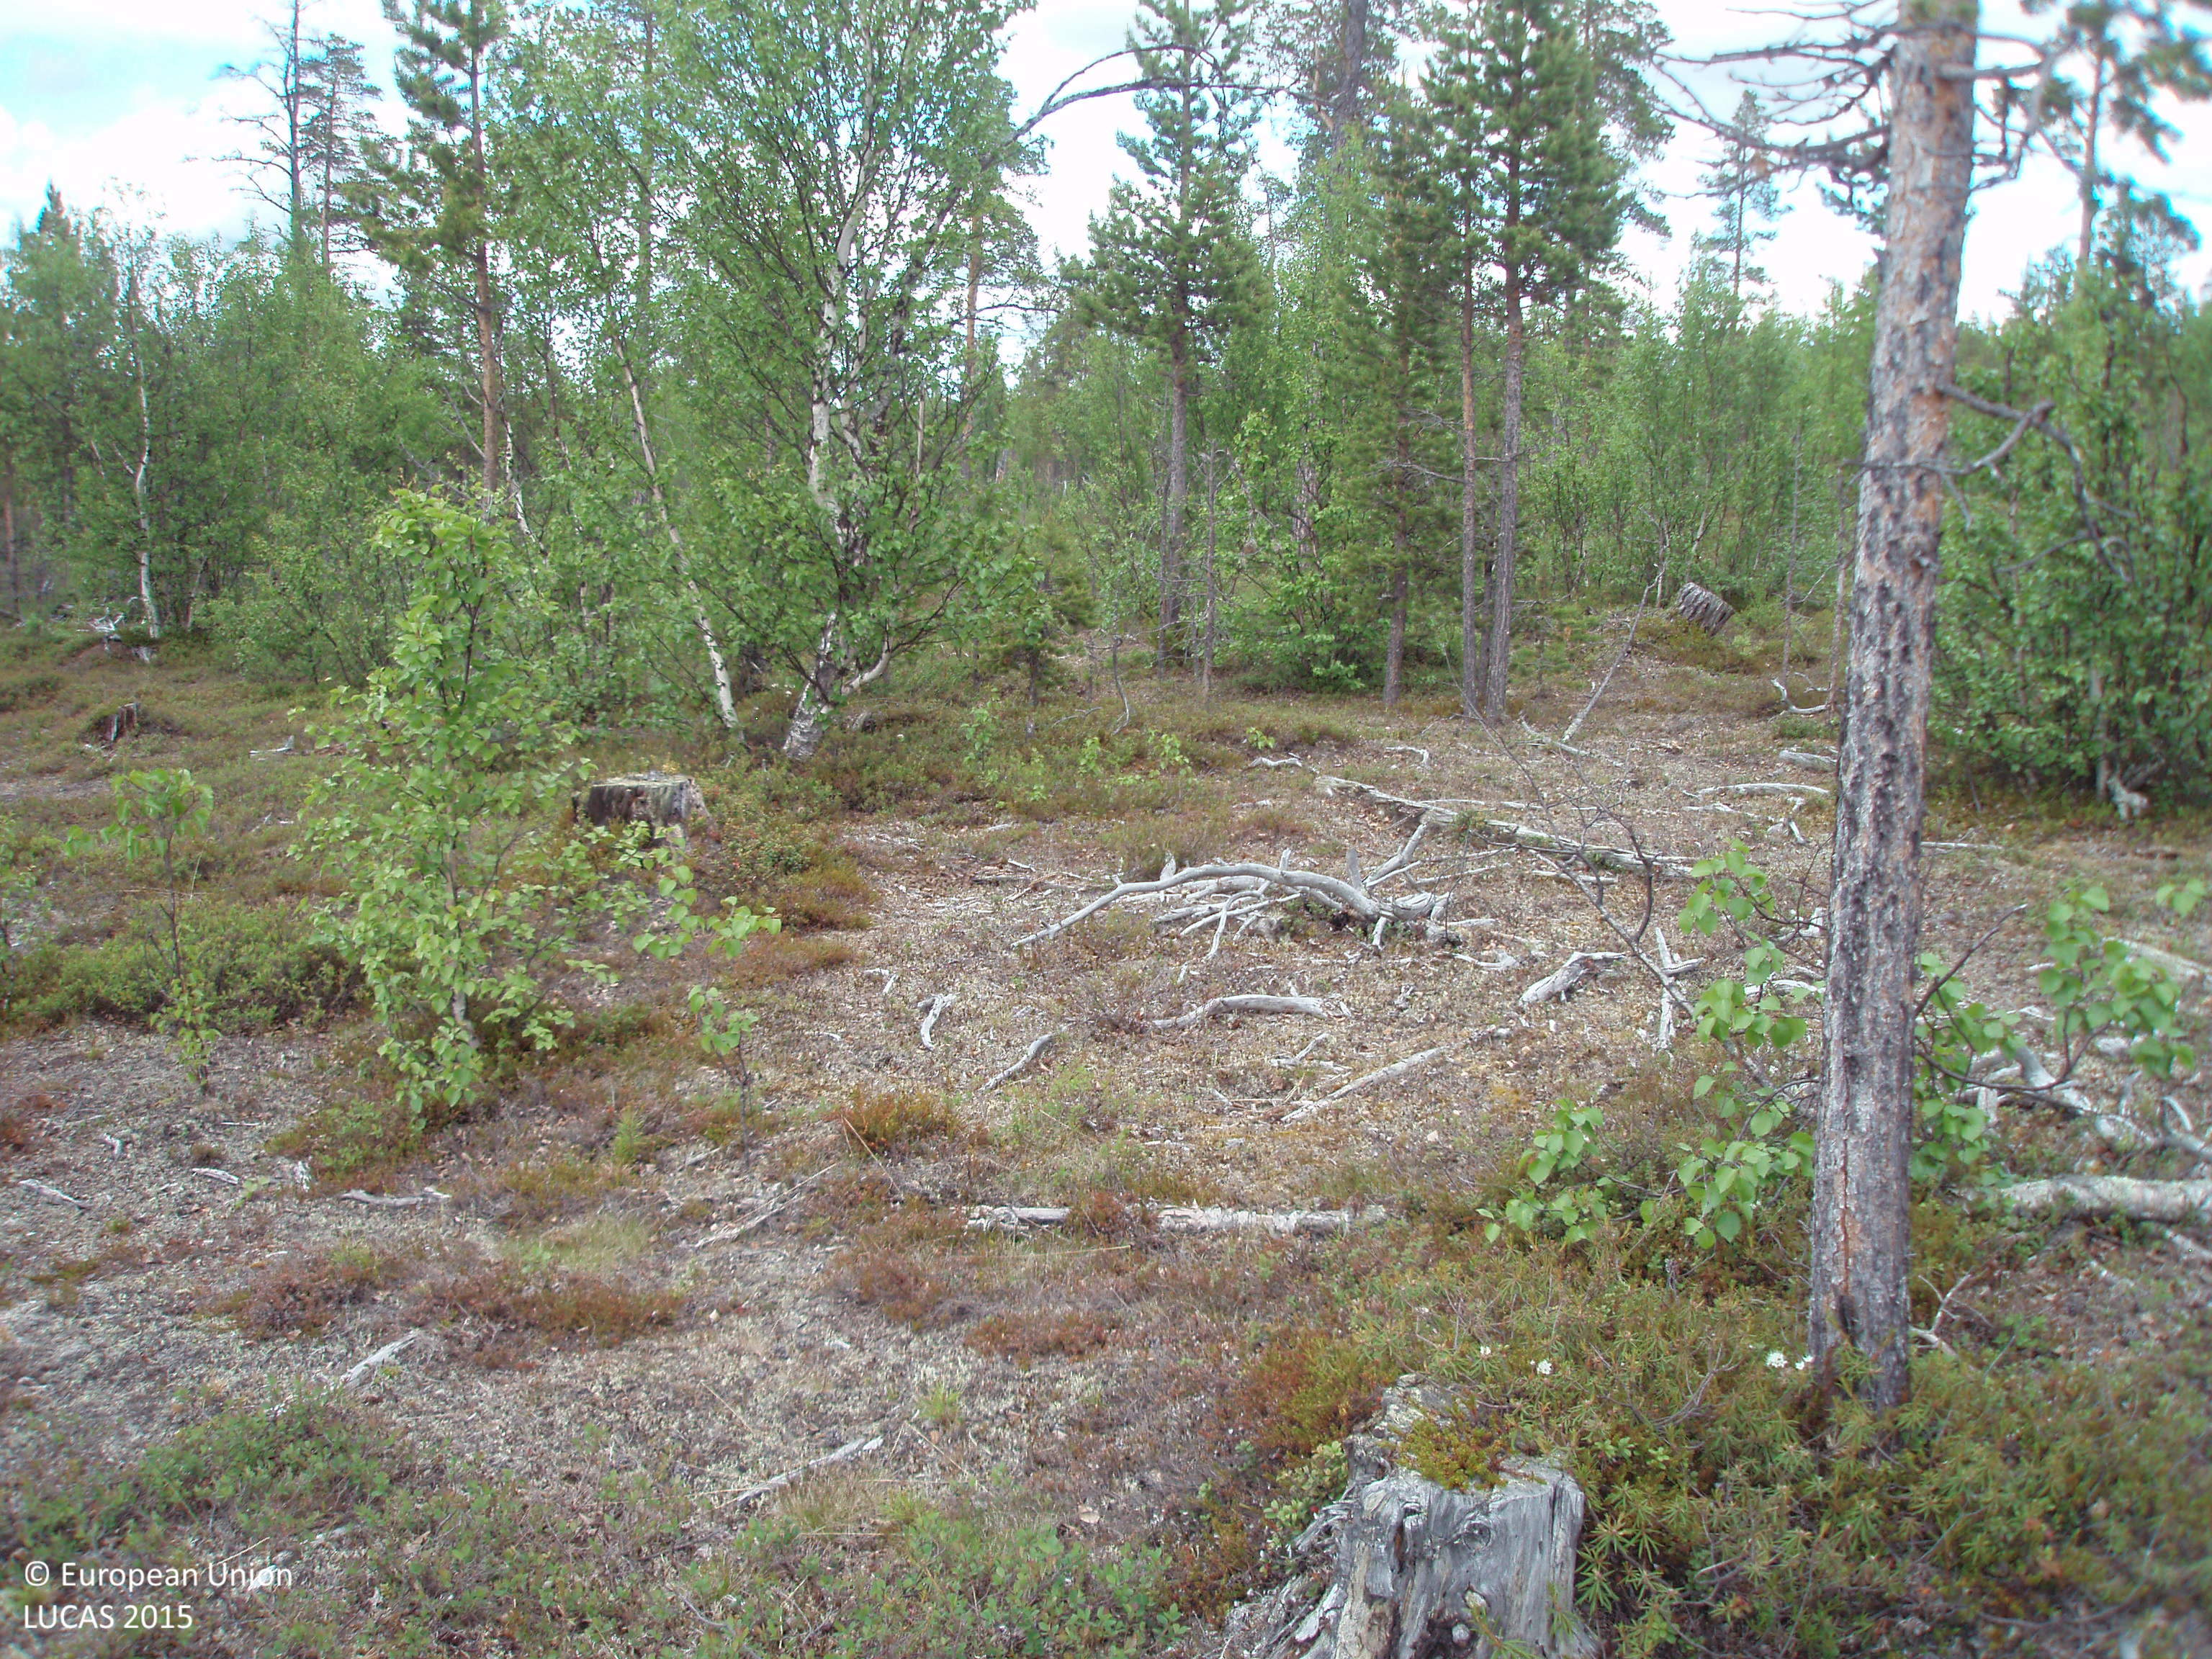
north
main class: Woodland
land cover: Pine dominated mixed woodland
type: boreal forest
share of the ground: 50 - 75 %
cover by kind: coniferous forest trees 30 %, shrubs 30 %, broadleaved forest trees 20 %, unconsolidated bare surface 20 %
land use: Forestry
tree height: > 5 m
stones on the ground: < 10 %
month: July
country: FI
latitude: 68.8732
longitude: 25.7690
